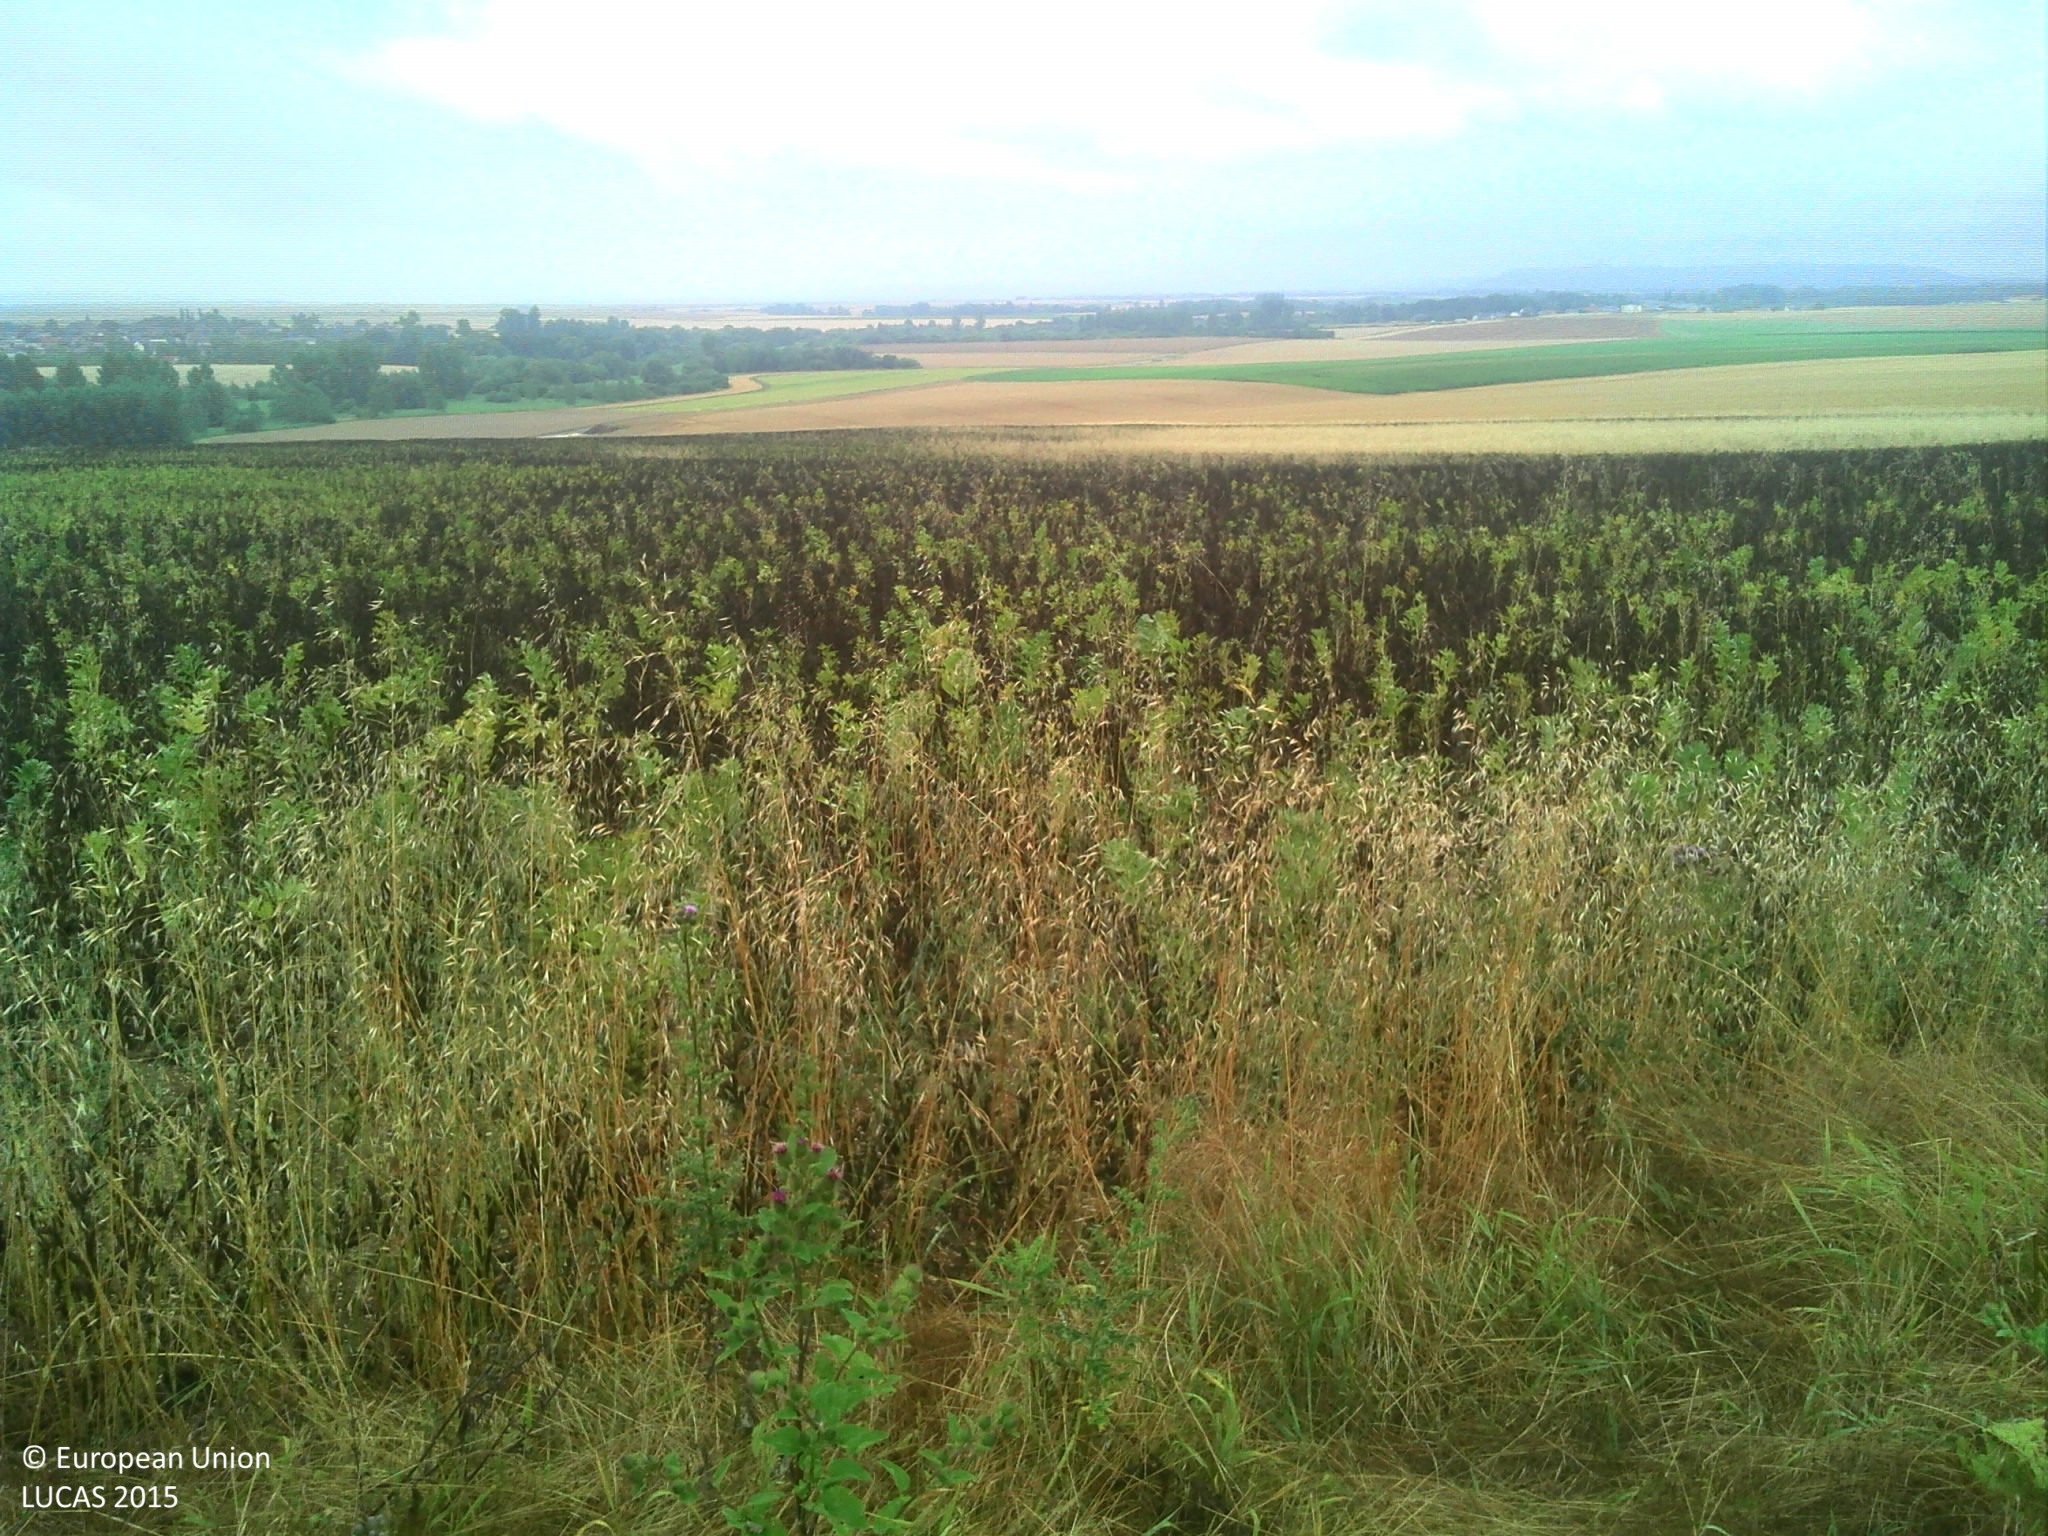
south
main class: Cropland
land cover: Other fibre and oleaginous crops
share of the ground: 50 - 75 %
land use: Agriculture (excluding fallow land and kitchen gardens)
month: July
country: FR
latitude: 49.6651
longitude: 3.6617
